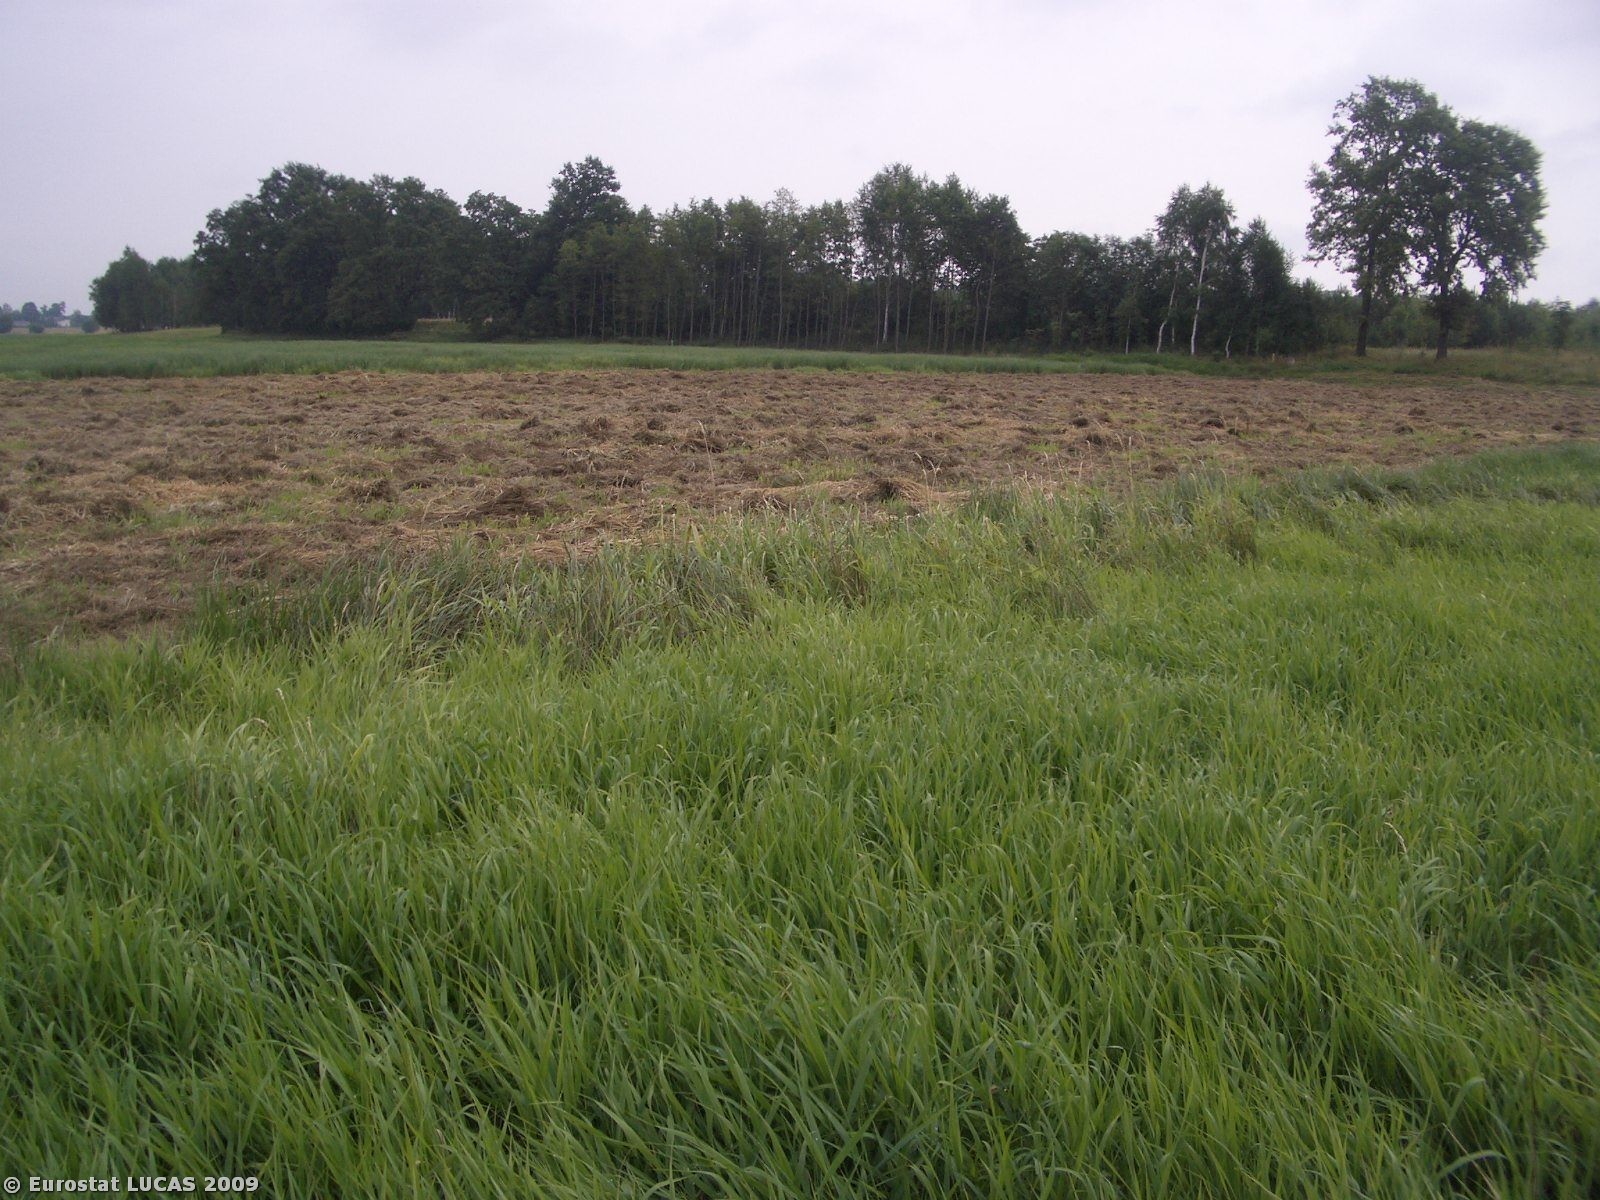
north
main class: Grassland
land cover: Grassland without tree/shrub cover
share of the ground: 50 - 75 %
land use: Agriculture (excluding fallow land and kitchen gardens)
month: August
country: PL
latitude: 51.9586
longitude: 23.2496
